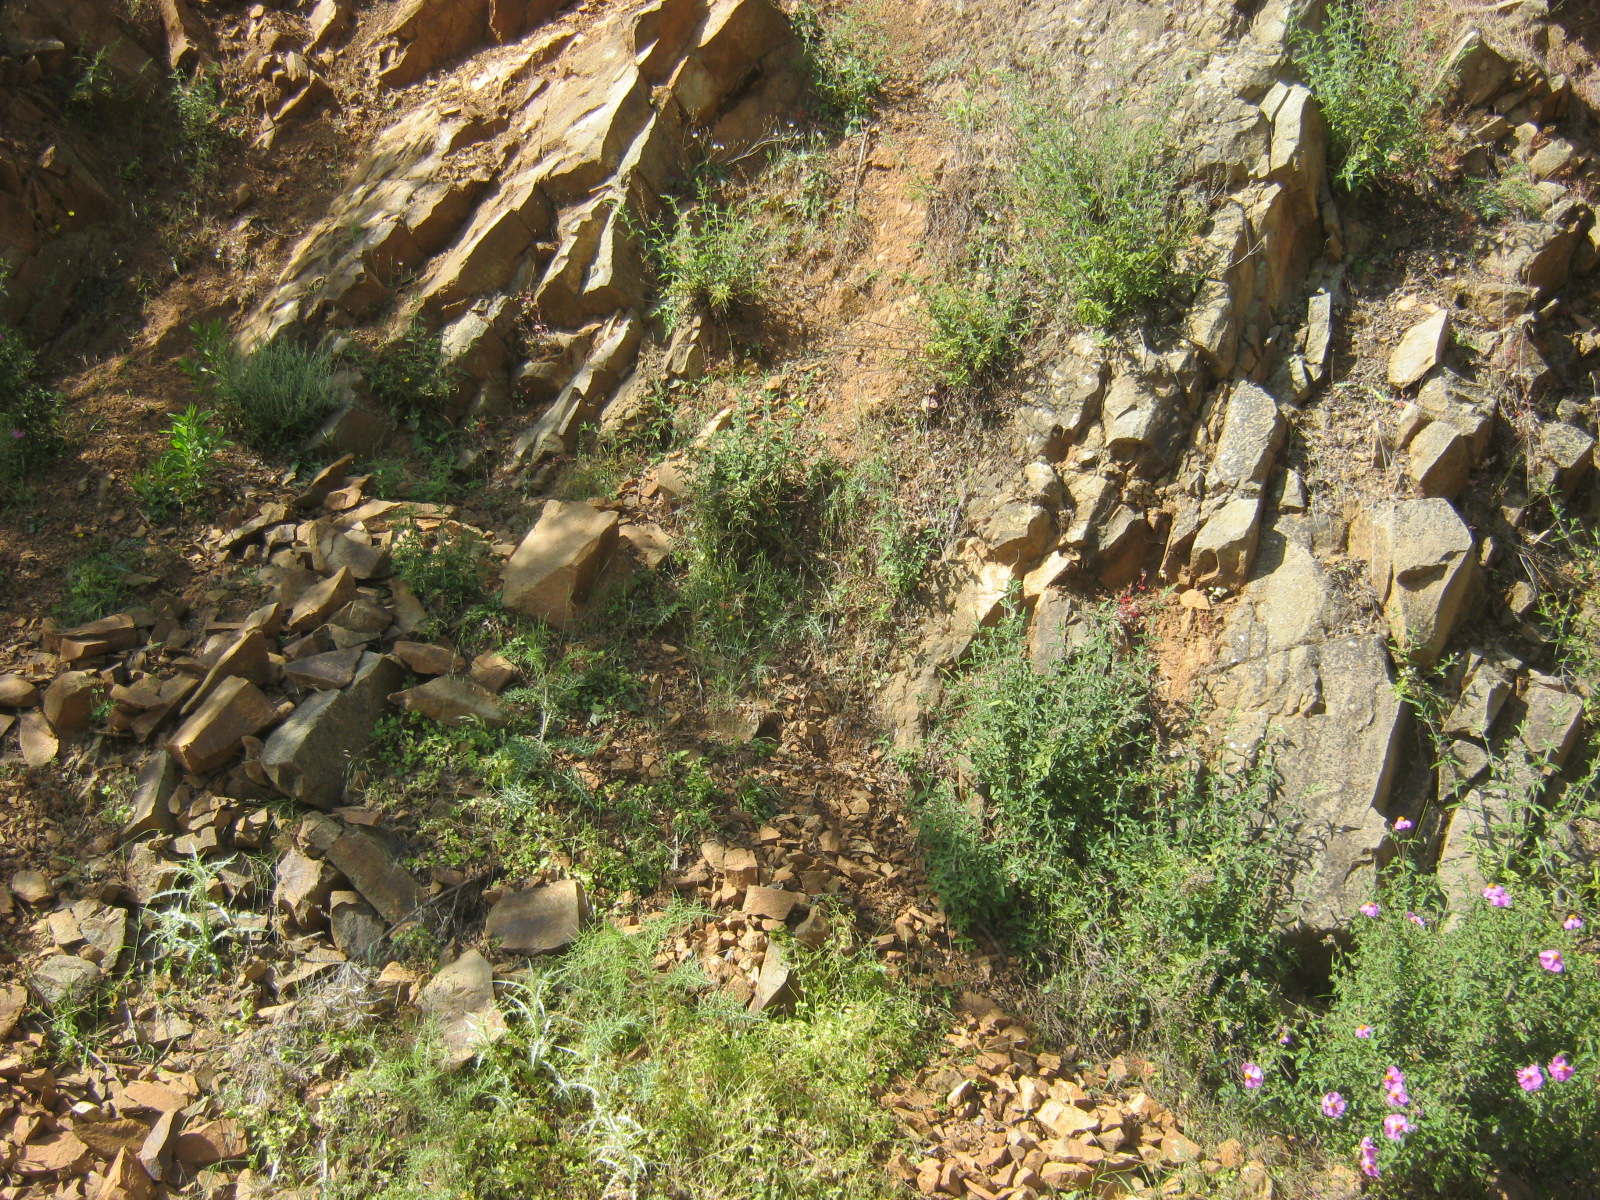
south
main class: Woodland
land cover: Pine dominated coniferous woodland
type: coniferous forest of the mediterranean region
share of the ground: 50 - 75 %
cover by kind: coniferous forest trees 60 %, shrubs 20 %, unconsolidated bare surface 20 %
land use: Forestry
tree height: > 5 m
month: May
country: CY
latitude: 35.0145
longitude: 32.7962
